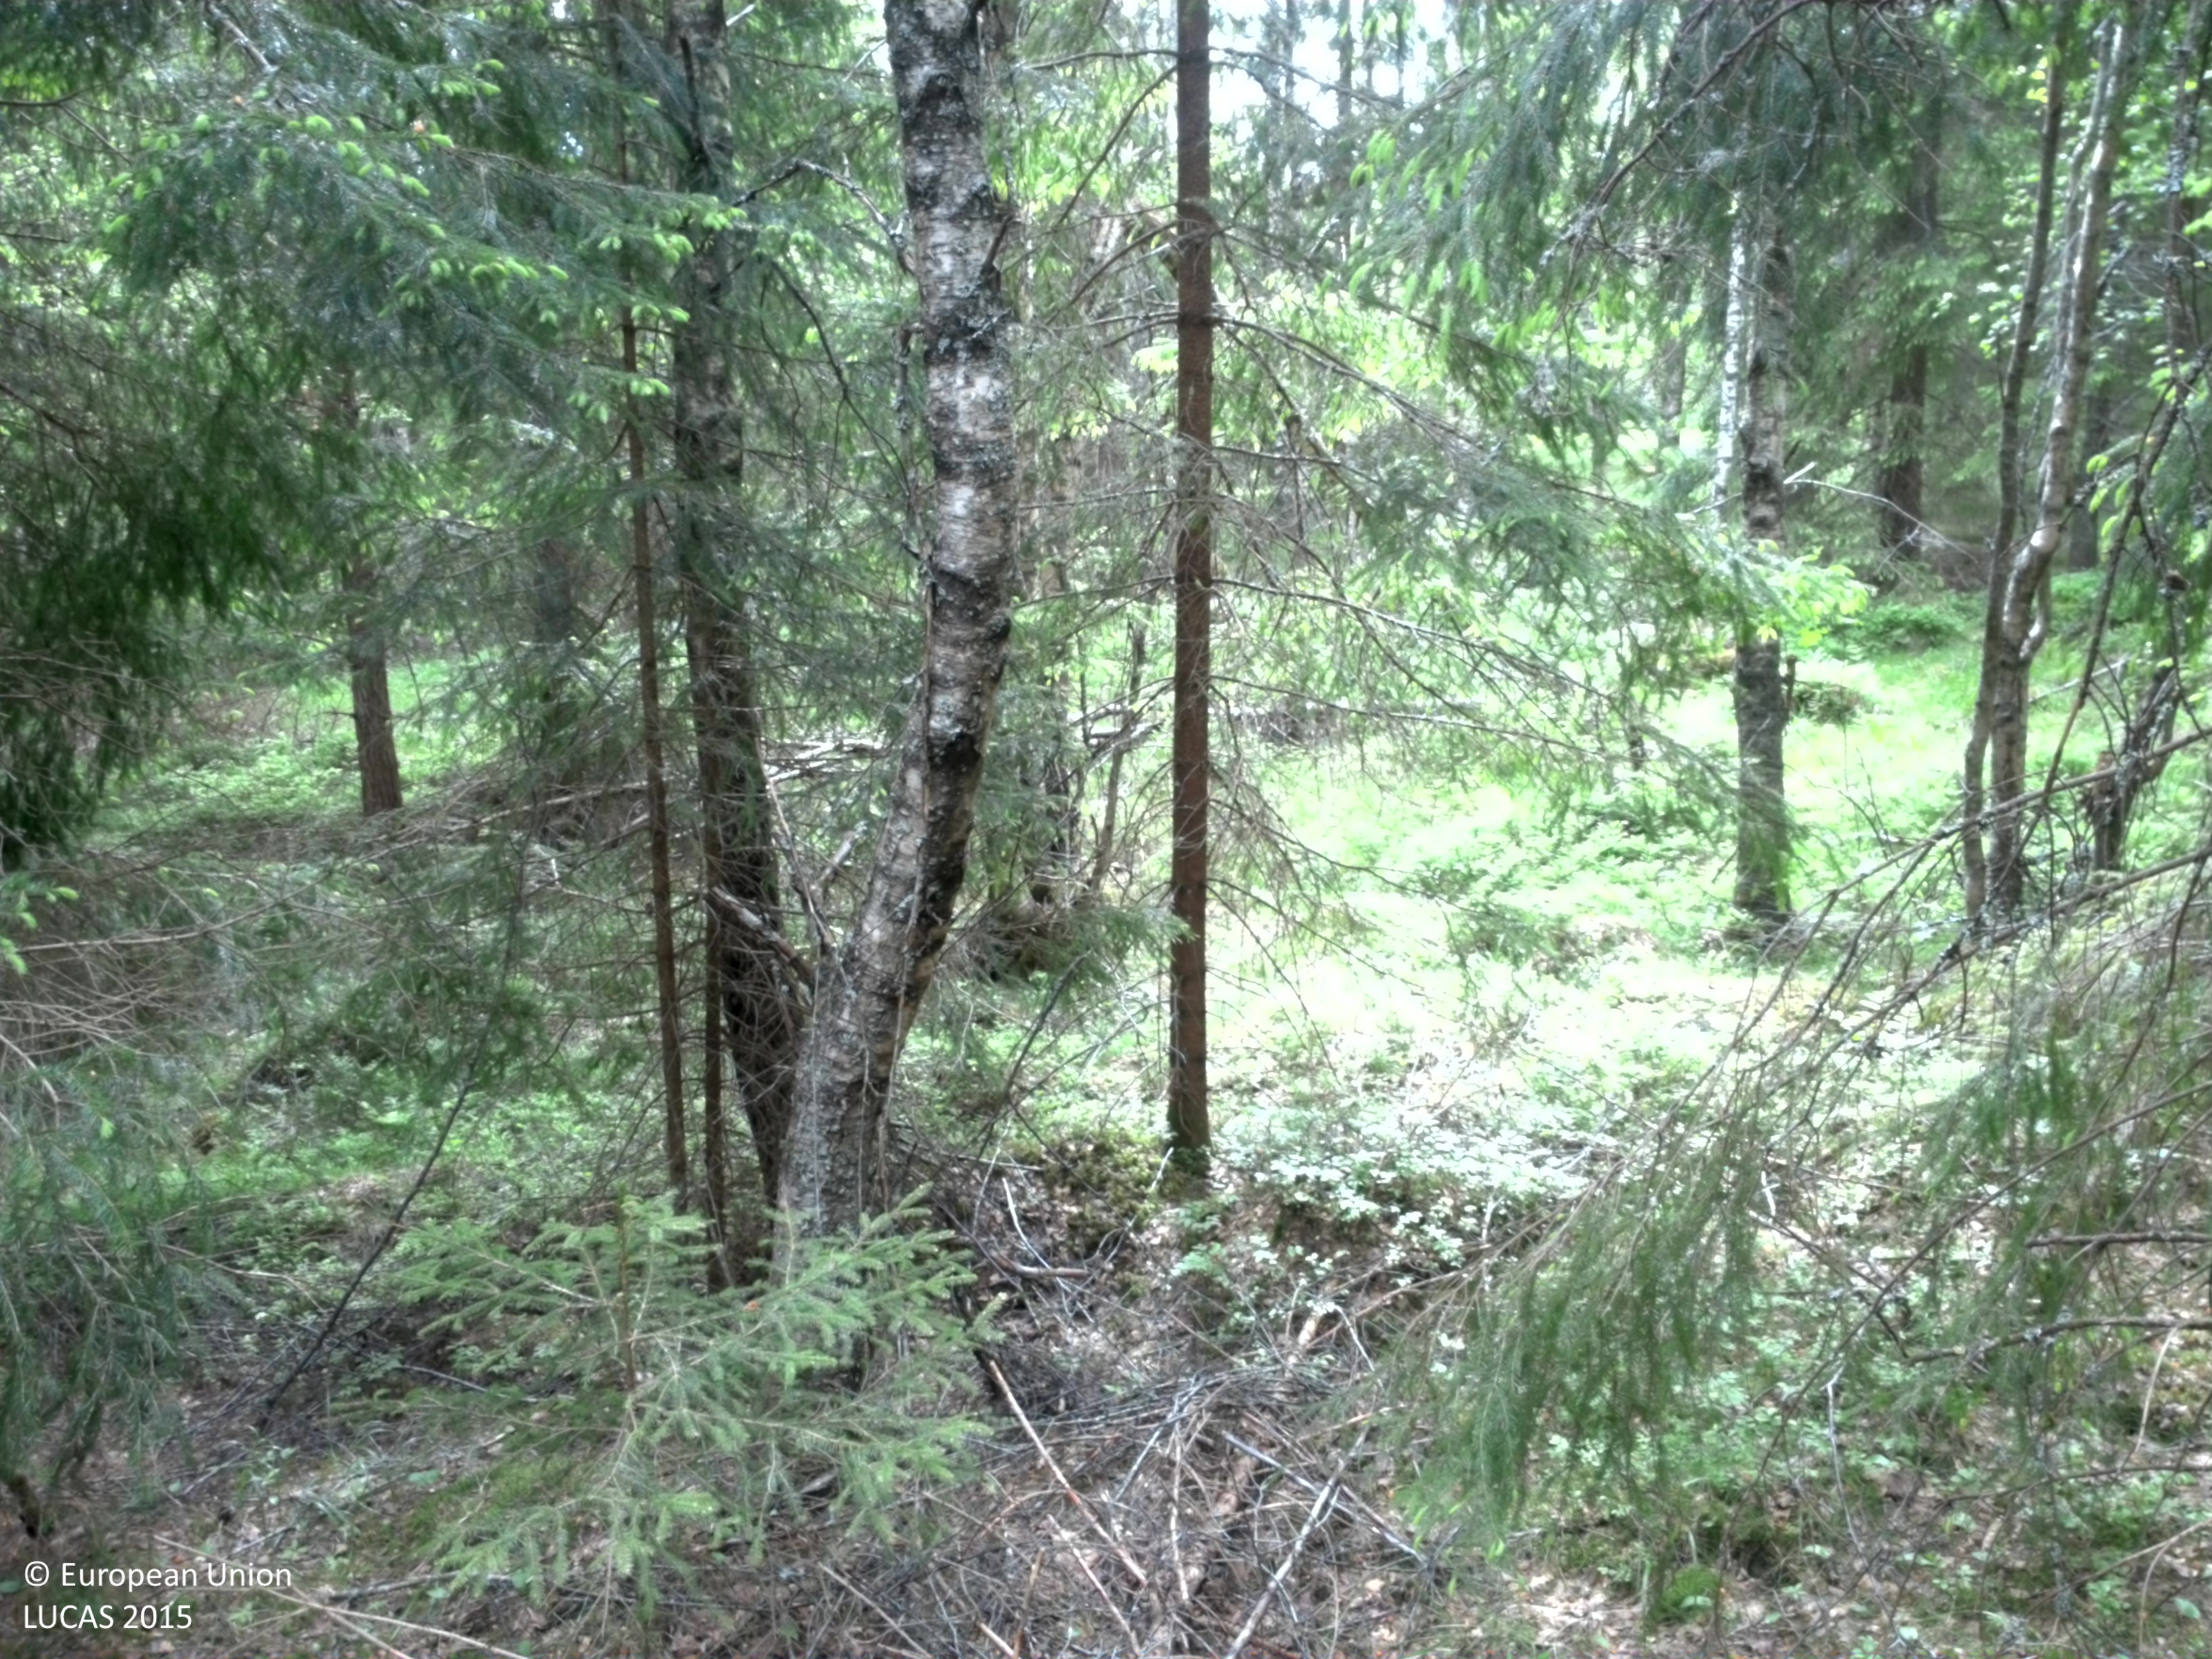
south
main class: Woodland
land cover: Spruce dominated mixed woodland
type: boreal forest
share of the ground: > 75 %
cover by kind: coniferous forest trees 40 %, broadleaved forest trees 35 %, shrubs 15 %, herbaceous plants 5 %, lichens and mosses 5 %
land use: Forestry
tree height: > 5 m
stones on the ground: < 10 %
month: June
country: SE
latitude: 59.5510
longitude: 14.4667
